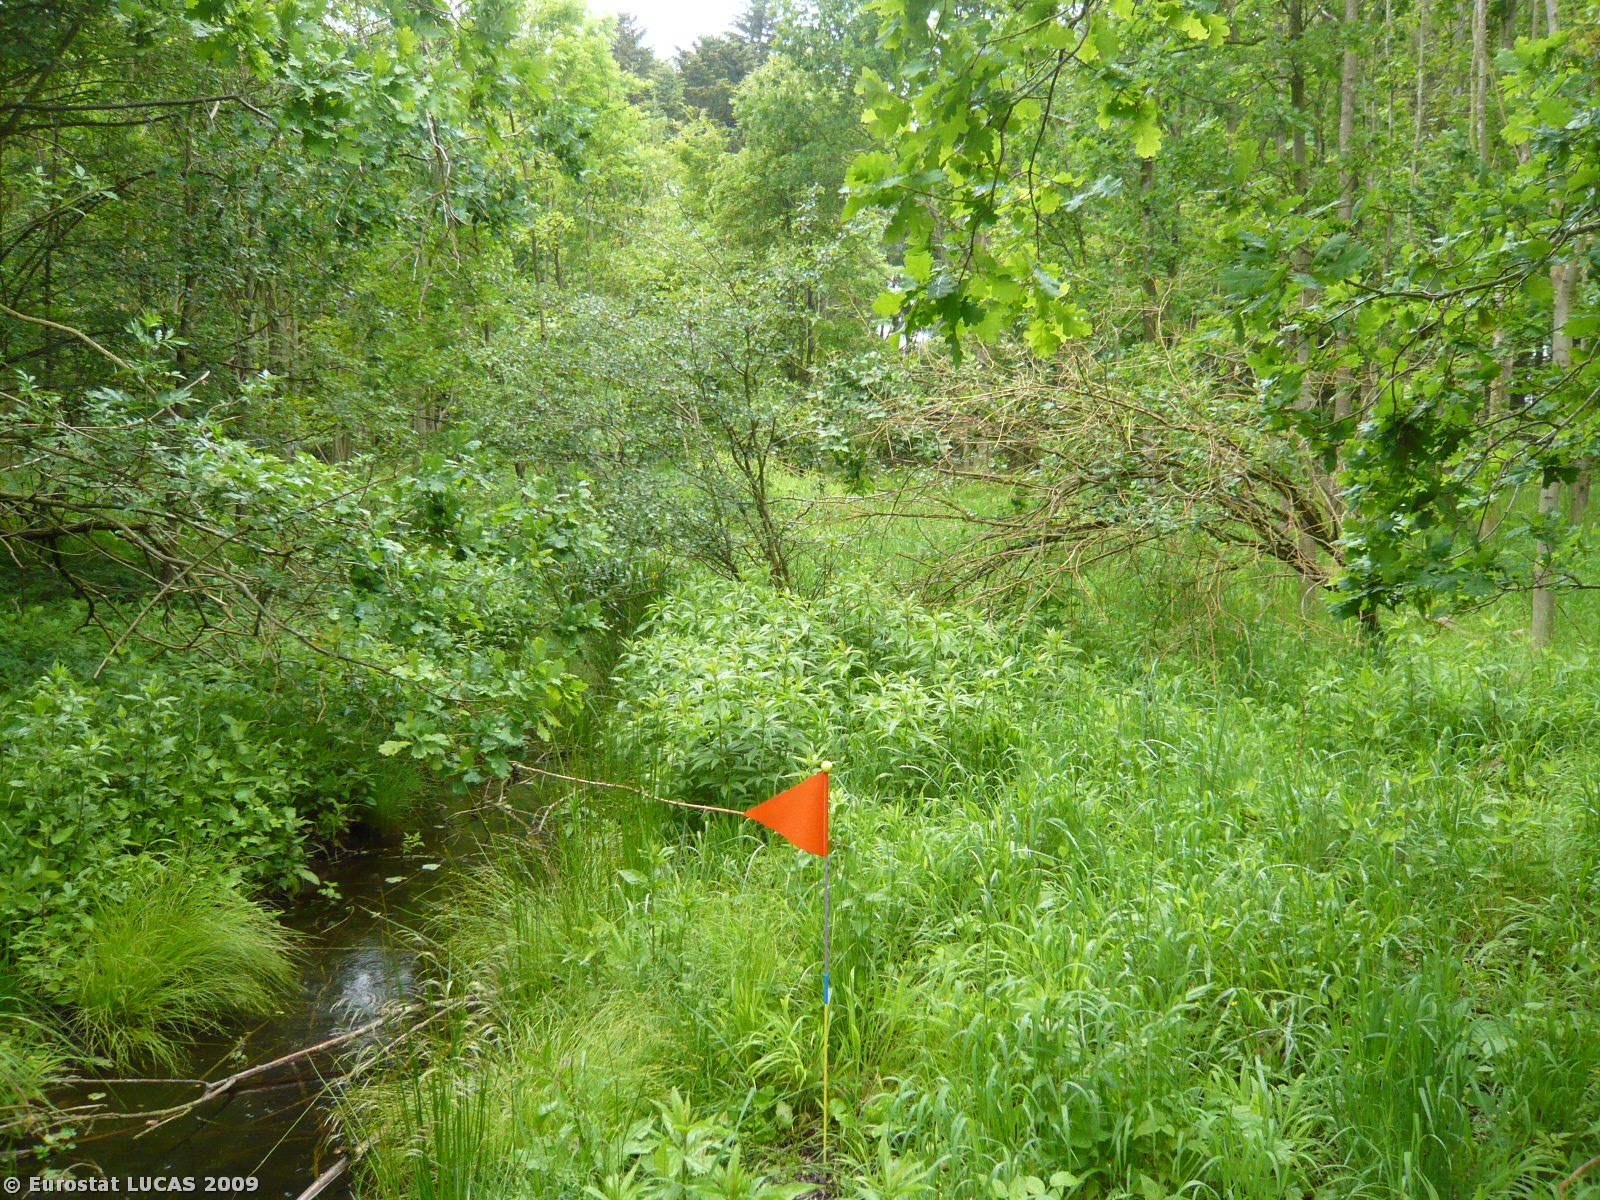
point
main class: Woodland
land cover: Broadleaved woodland
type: plantations and self-sown exotic forest
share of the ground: > 75 %
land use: Forestry
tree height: > 5 m
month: June
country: DK
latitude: 54.7532
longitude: 11.9100
